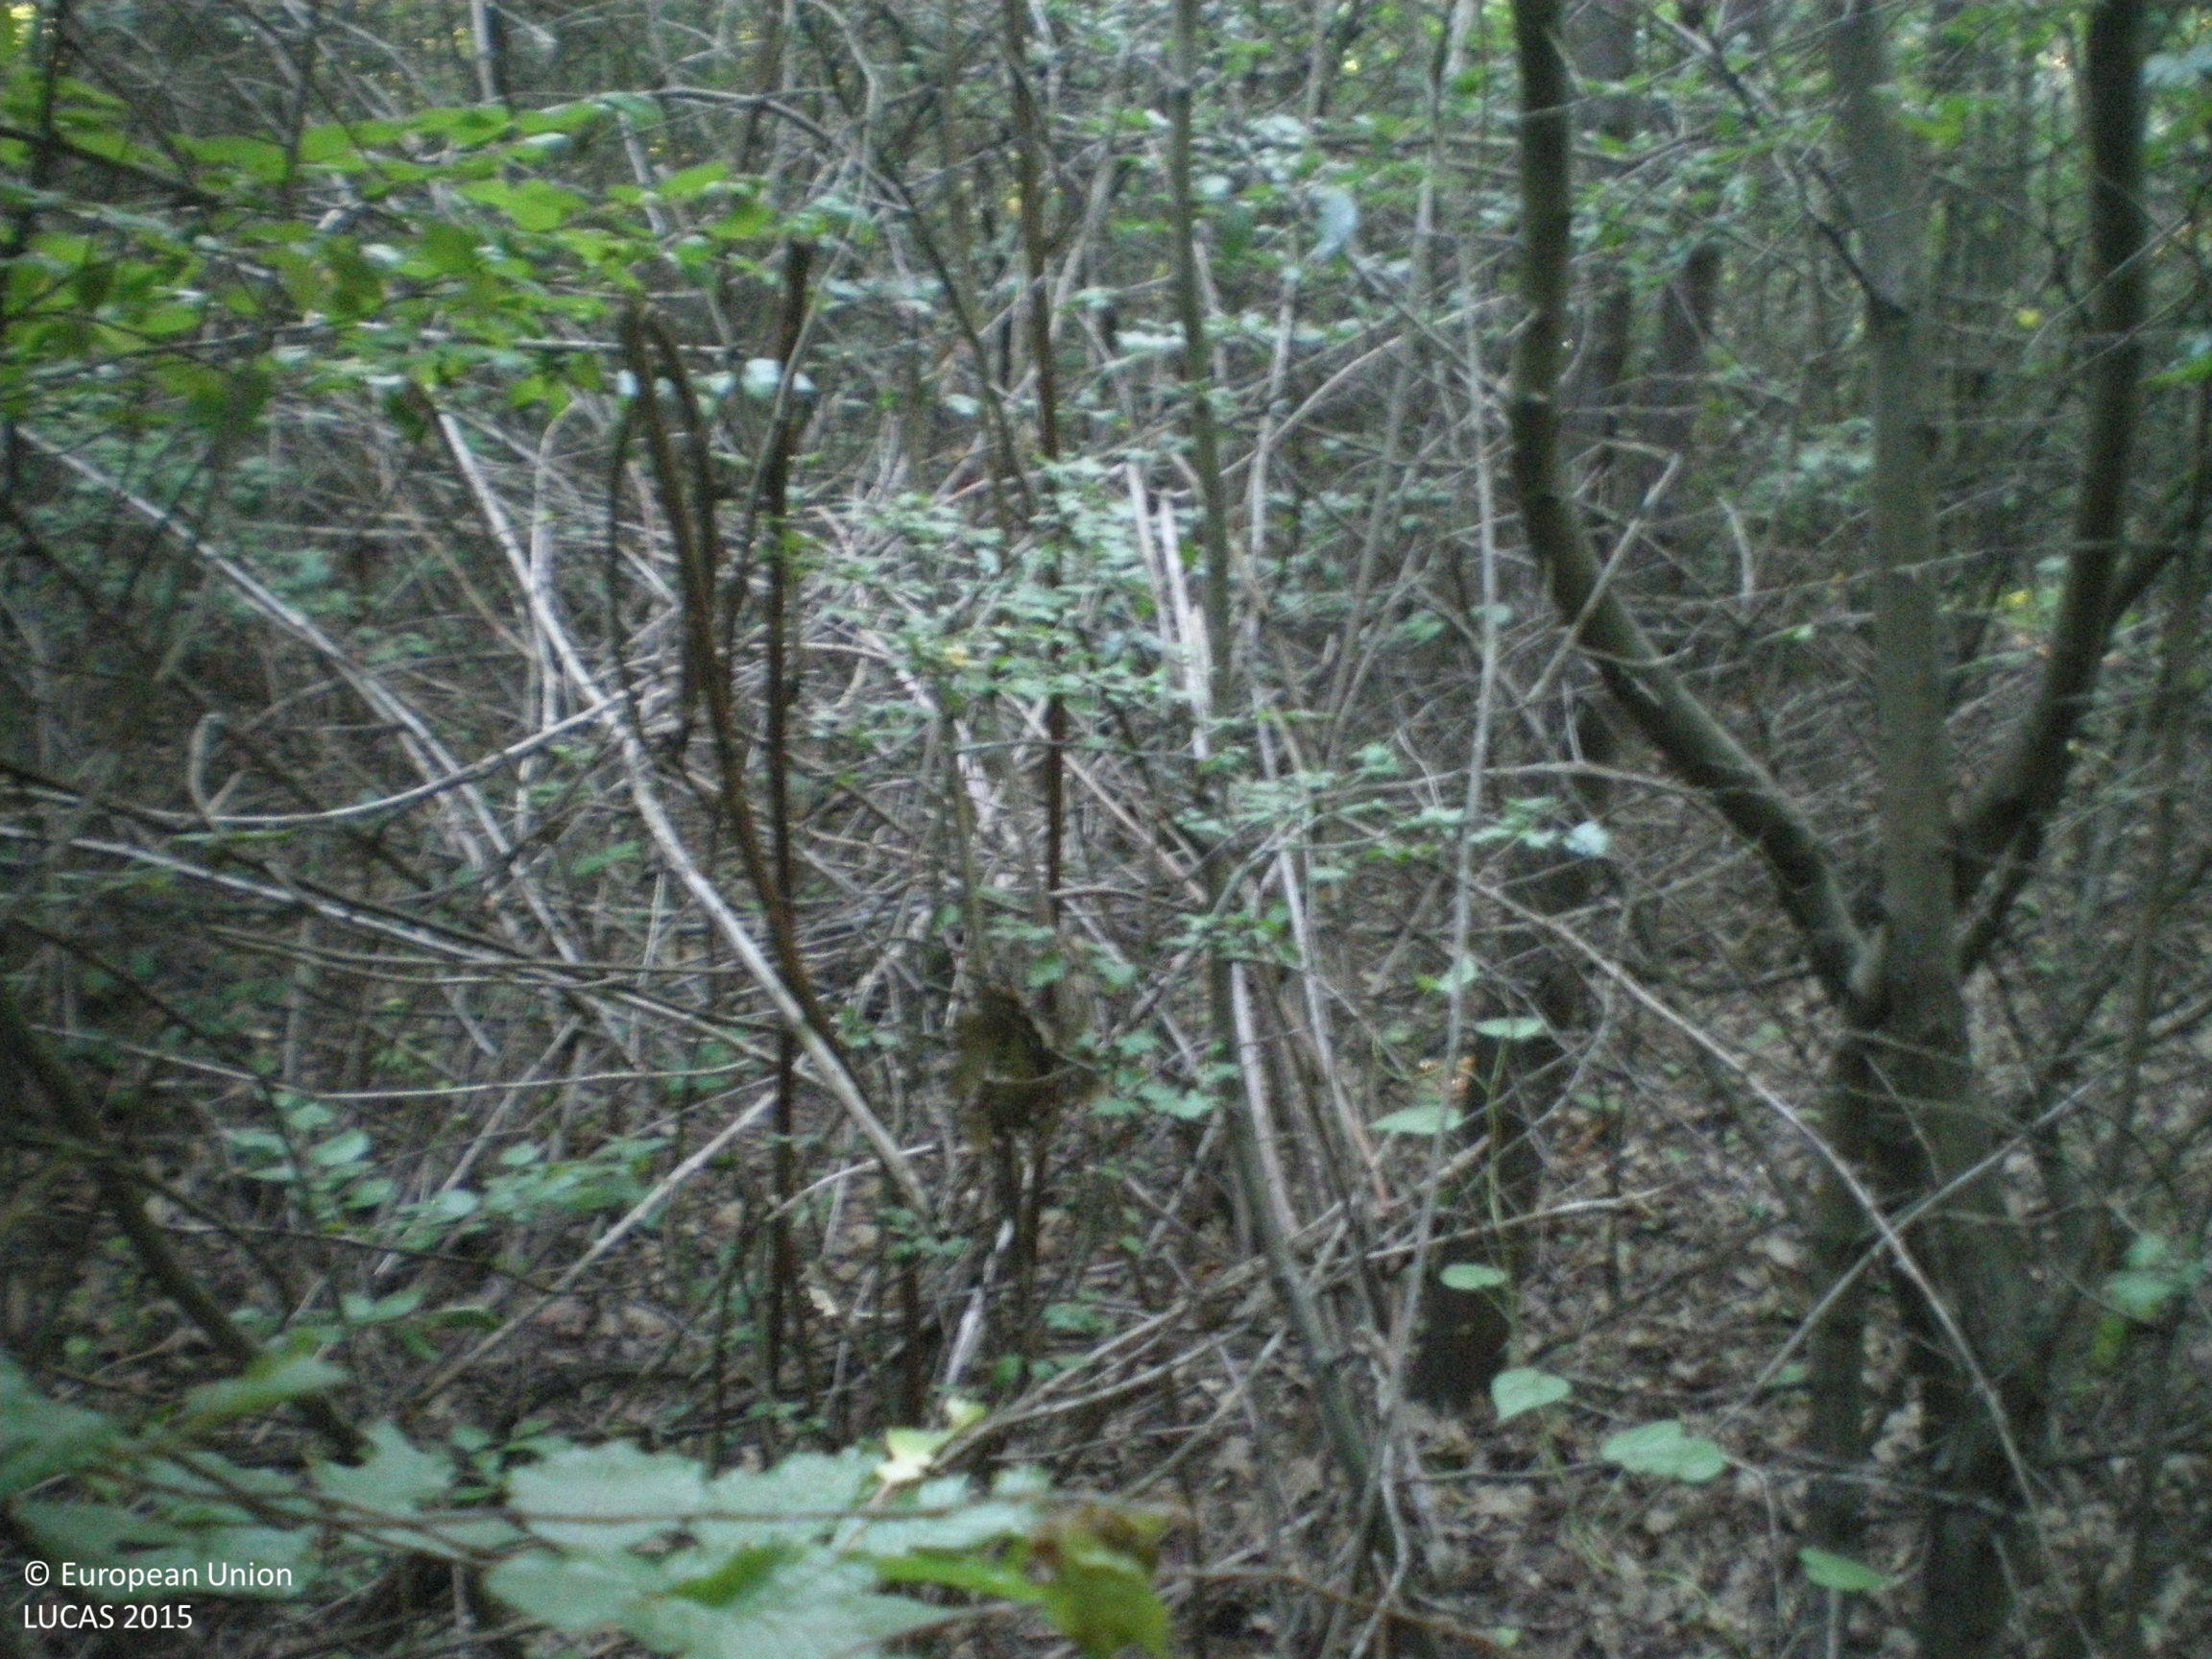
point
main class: Woodland
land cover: Broadleaved woodland
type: mesophytic deciduous forest
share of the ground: > 75 %
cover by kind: broadleaved forest trees 90 %, herbaceous plants 10 %
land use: Forestry
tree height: > 5 m
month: June
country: BG
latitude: 42.4246
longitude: 25.1452
